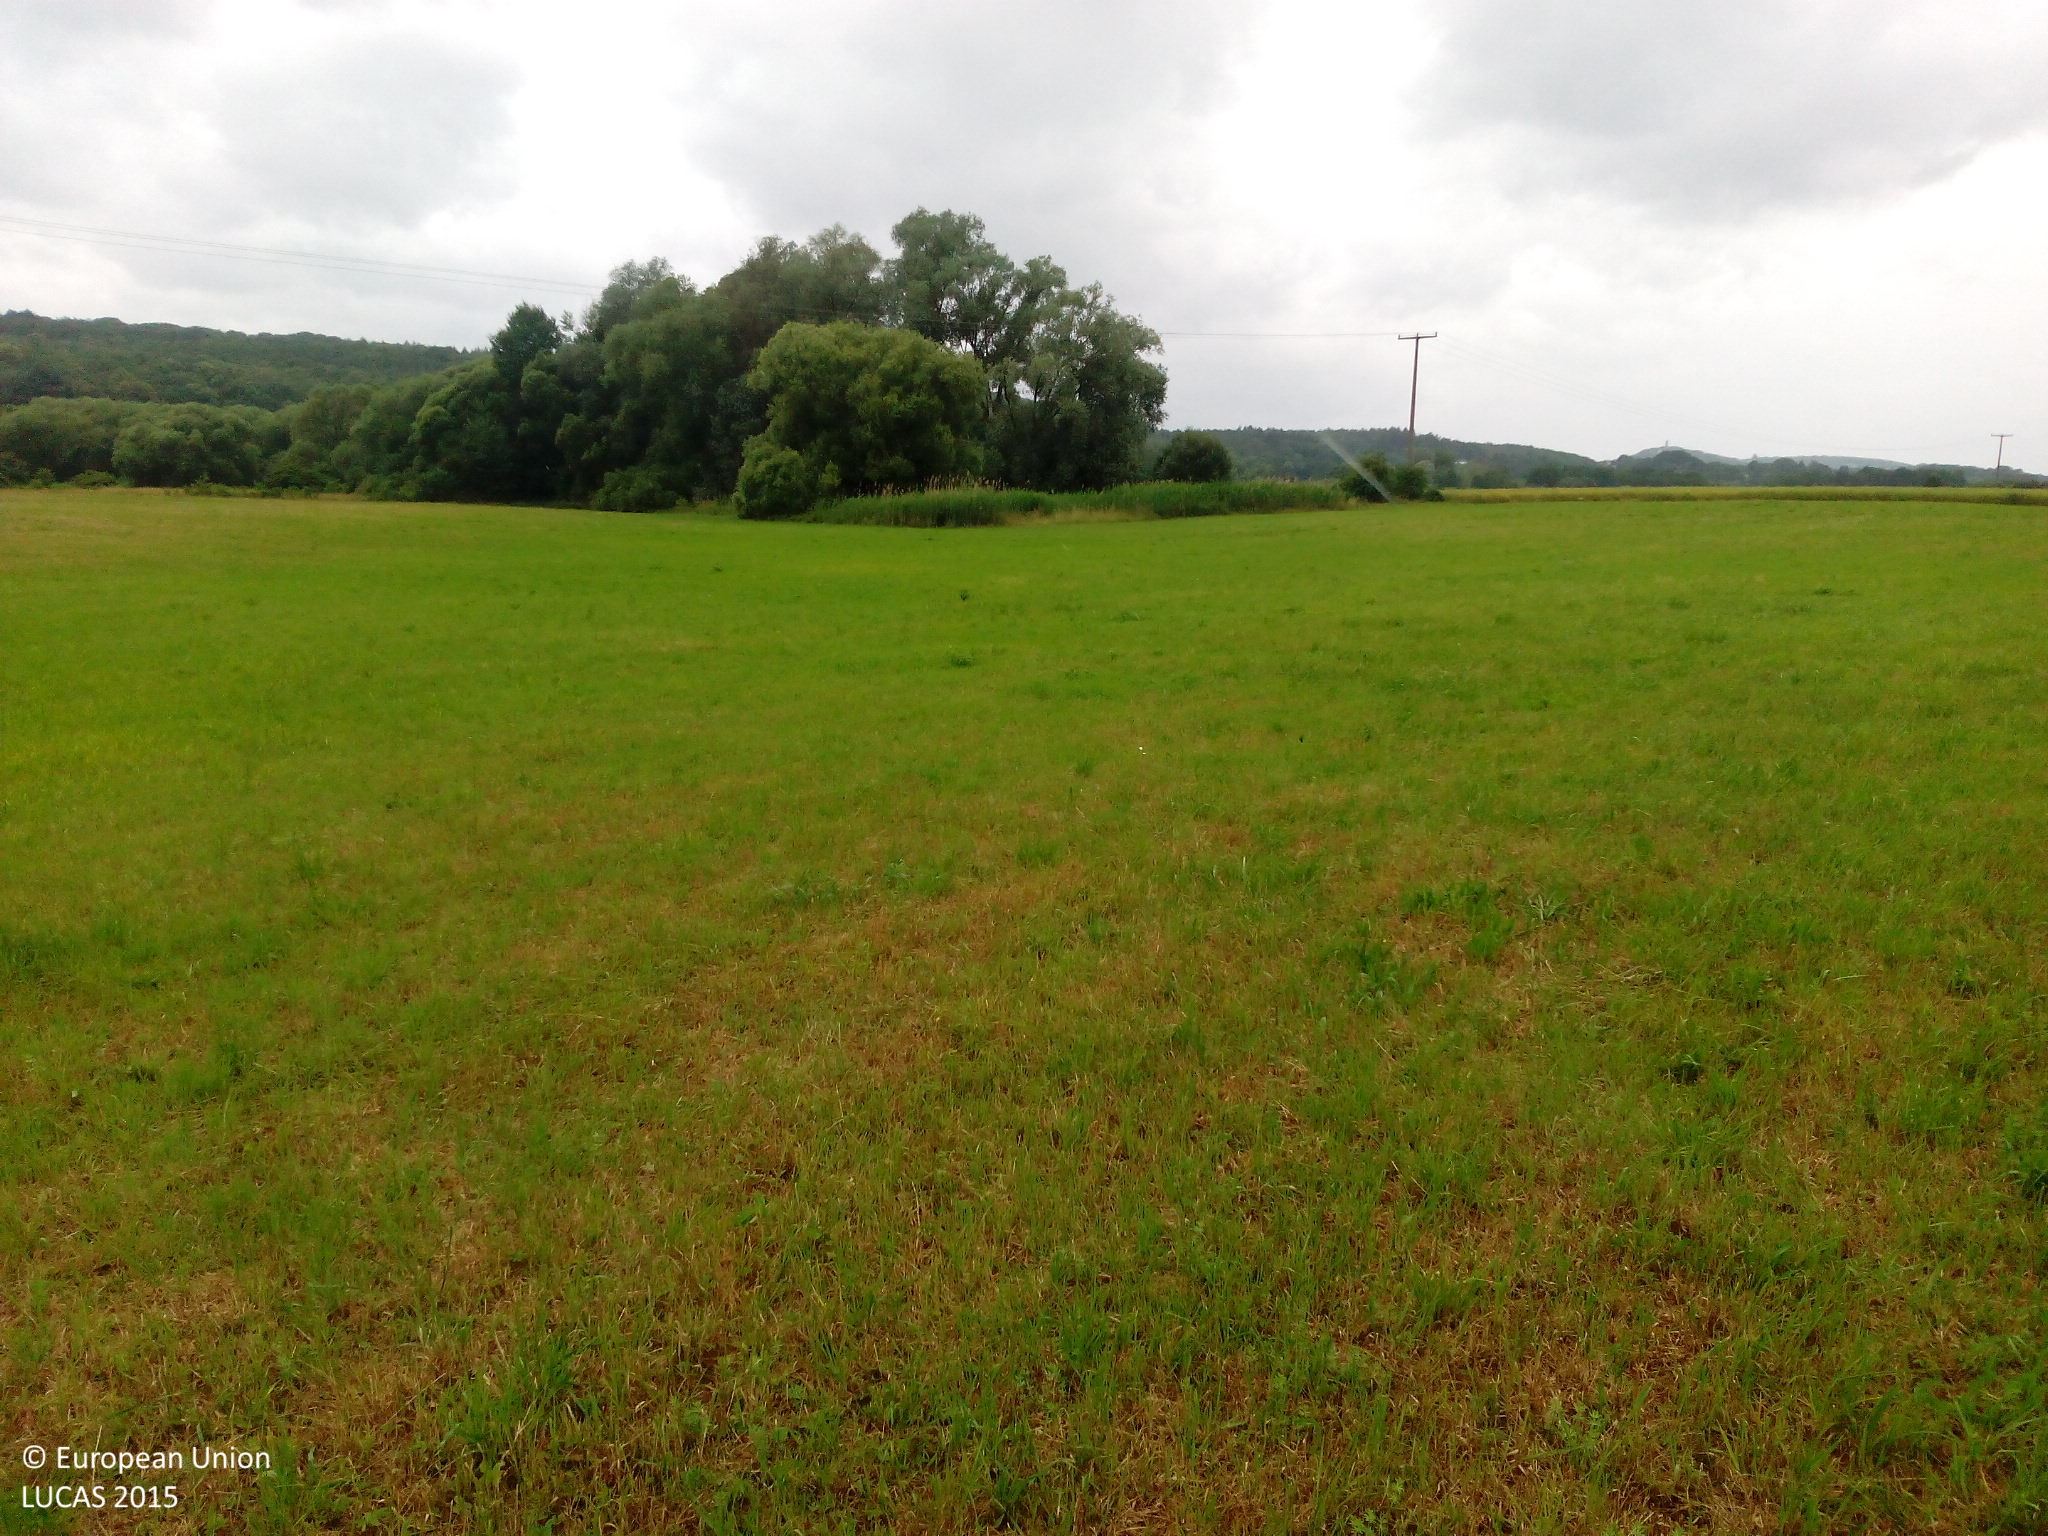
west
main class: Grassland
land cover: Grassland without tree/shrub cover
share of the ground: > 75 %
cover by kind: herbaceous plants 100 %
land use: Agriculture (excluding fallow land and kitchen gardens)
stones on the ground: < 10 %
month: June
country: DE
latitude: 49.8567
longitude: 10.9316
